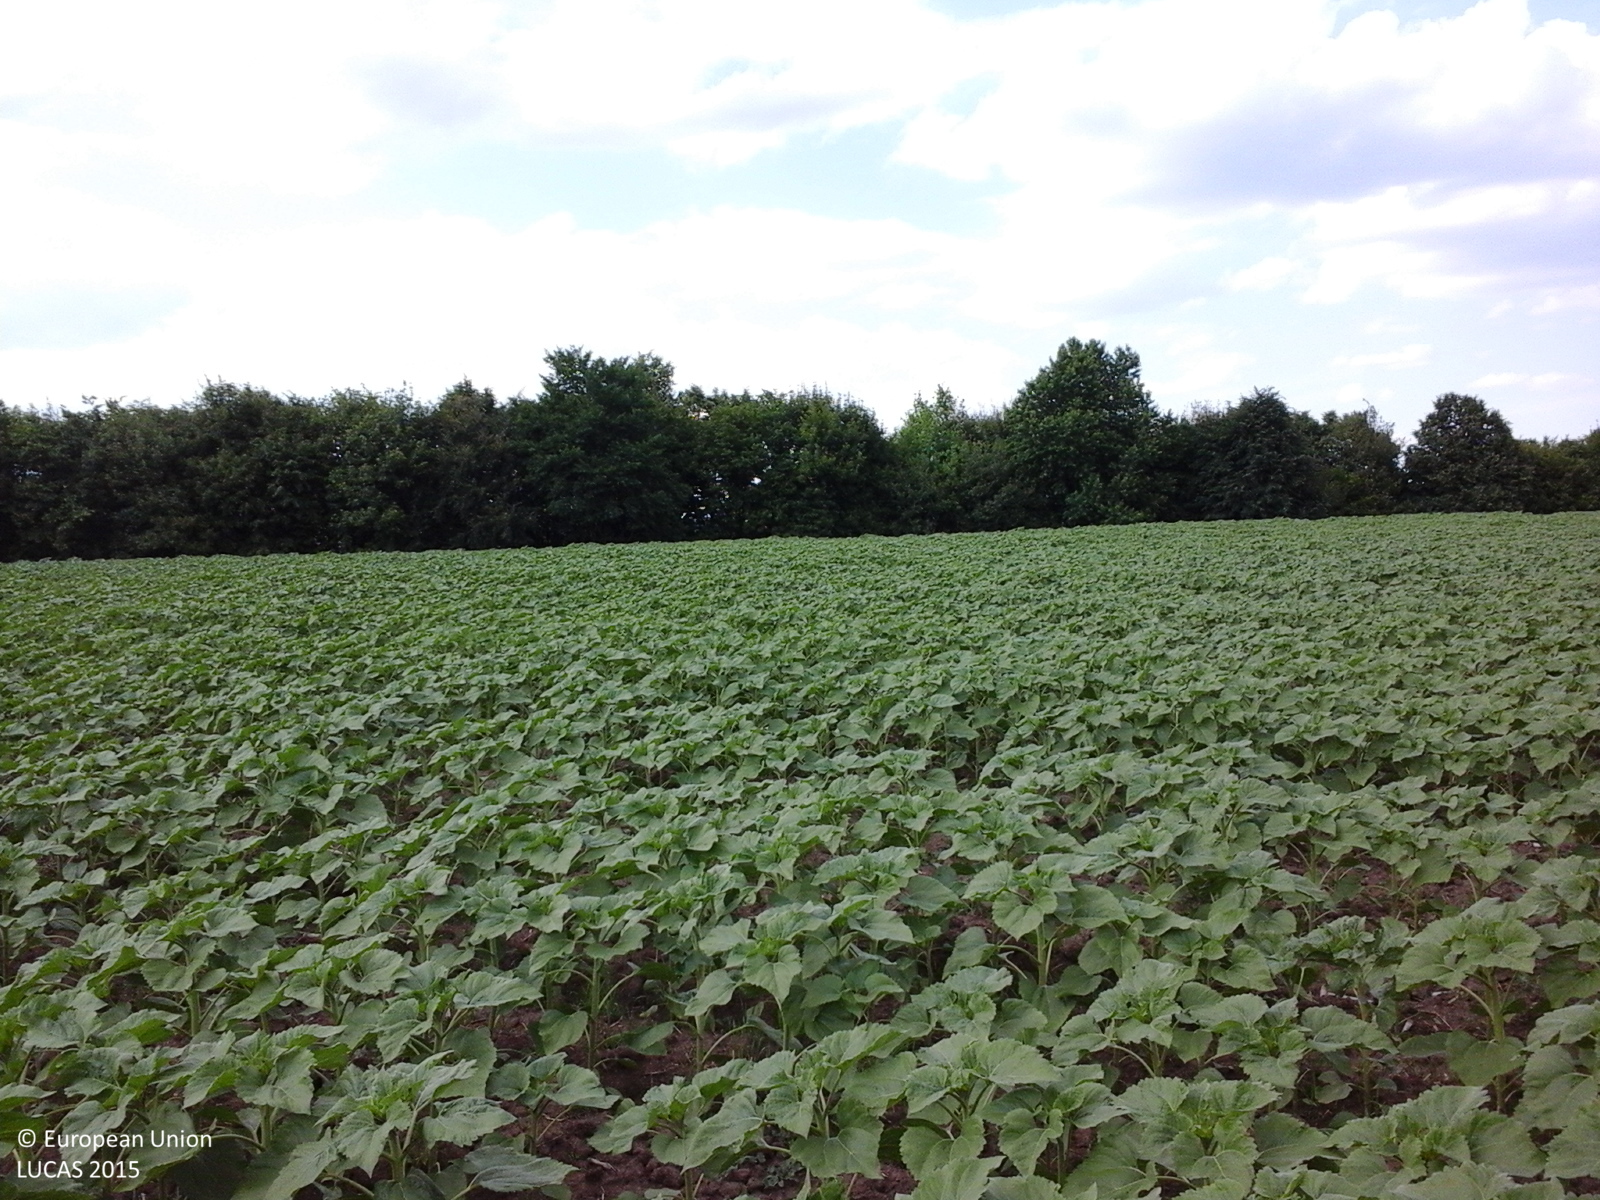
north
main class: Cropland
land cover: Sunflower
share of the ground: > 75 %
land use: Agriculture (excluding fallow land and kitchen gardens)
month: June
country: RO
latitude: 47.4496
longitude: 26.3578
